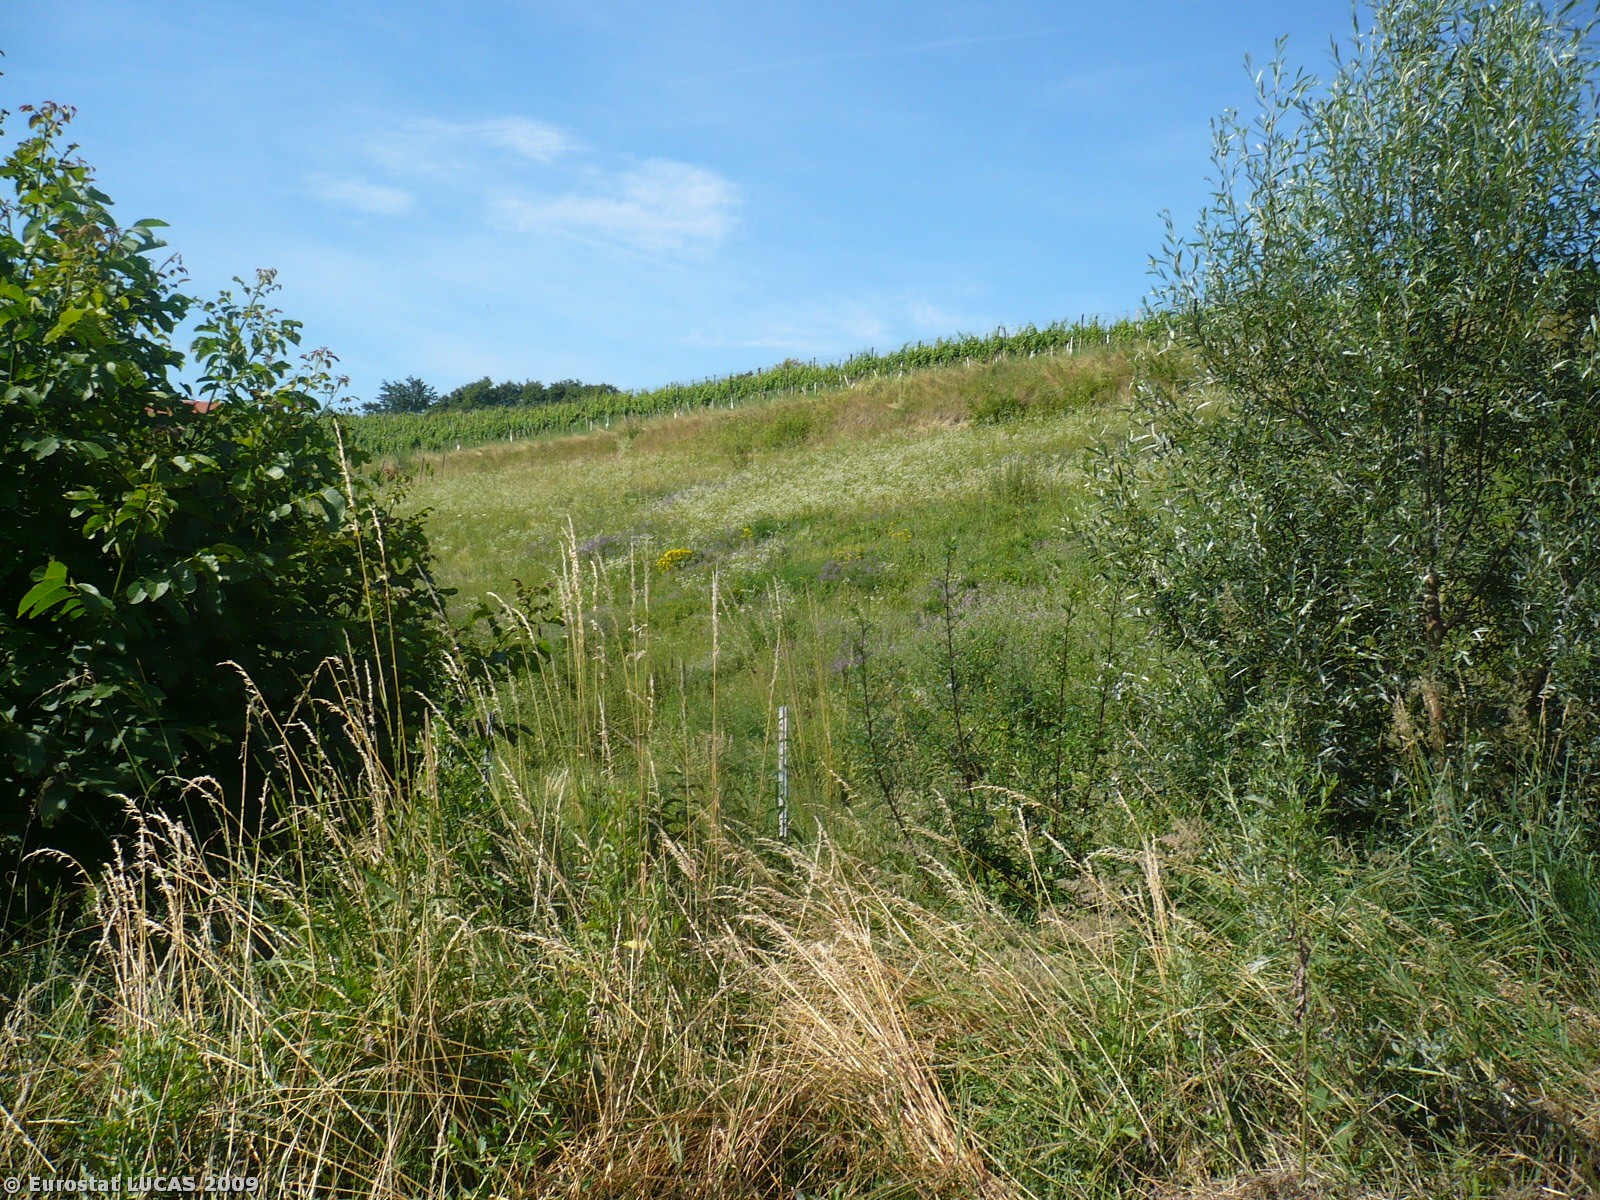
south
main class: Grassland
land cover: Grassland without tree/shrub cover
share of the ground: > 75 %
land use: Agriculture (excluding fallow land and kitchen gardens)
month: June
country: SI
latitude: 46.6136
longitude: 16.0458
